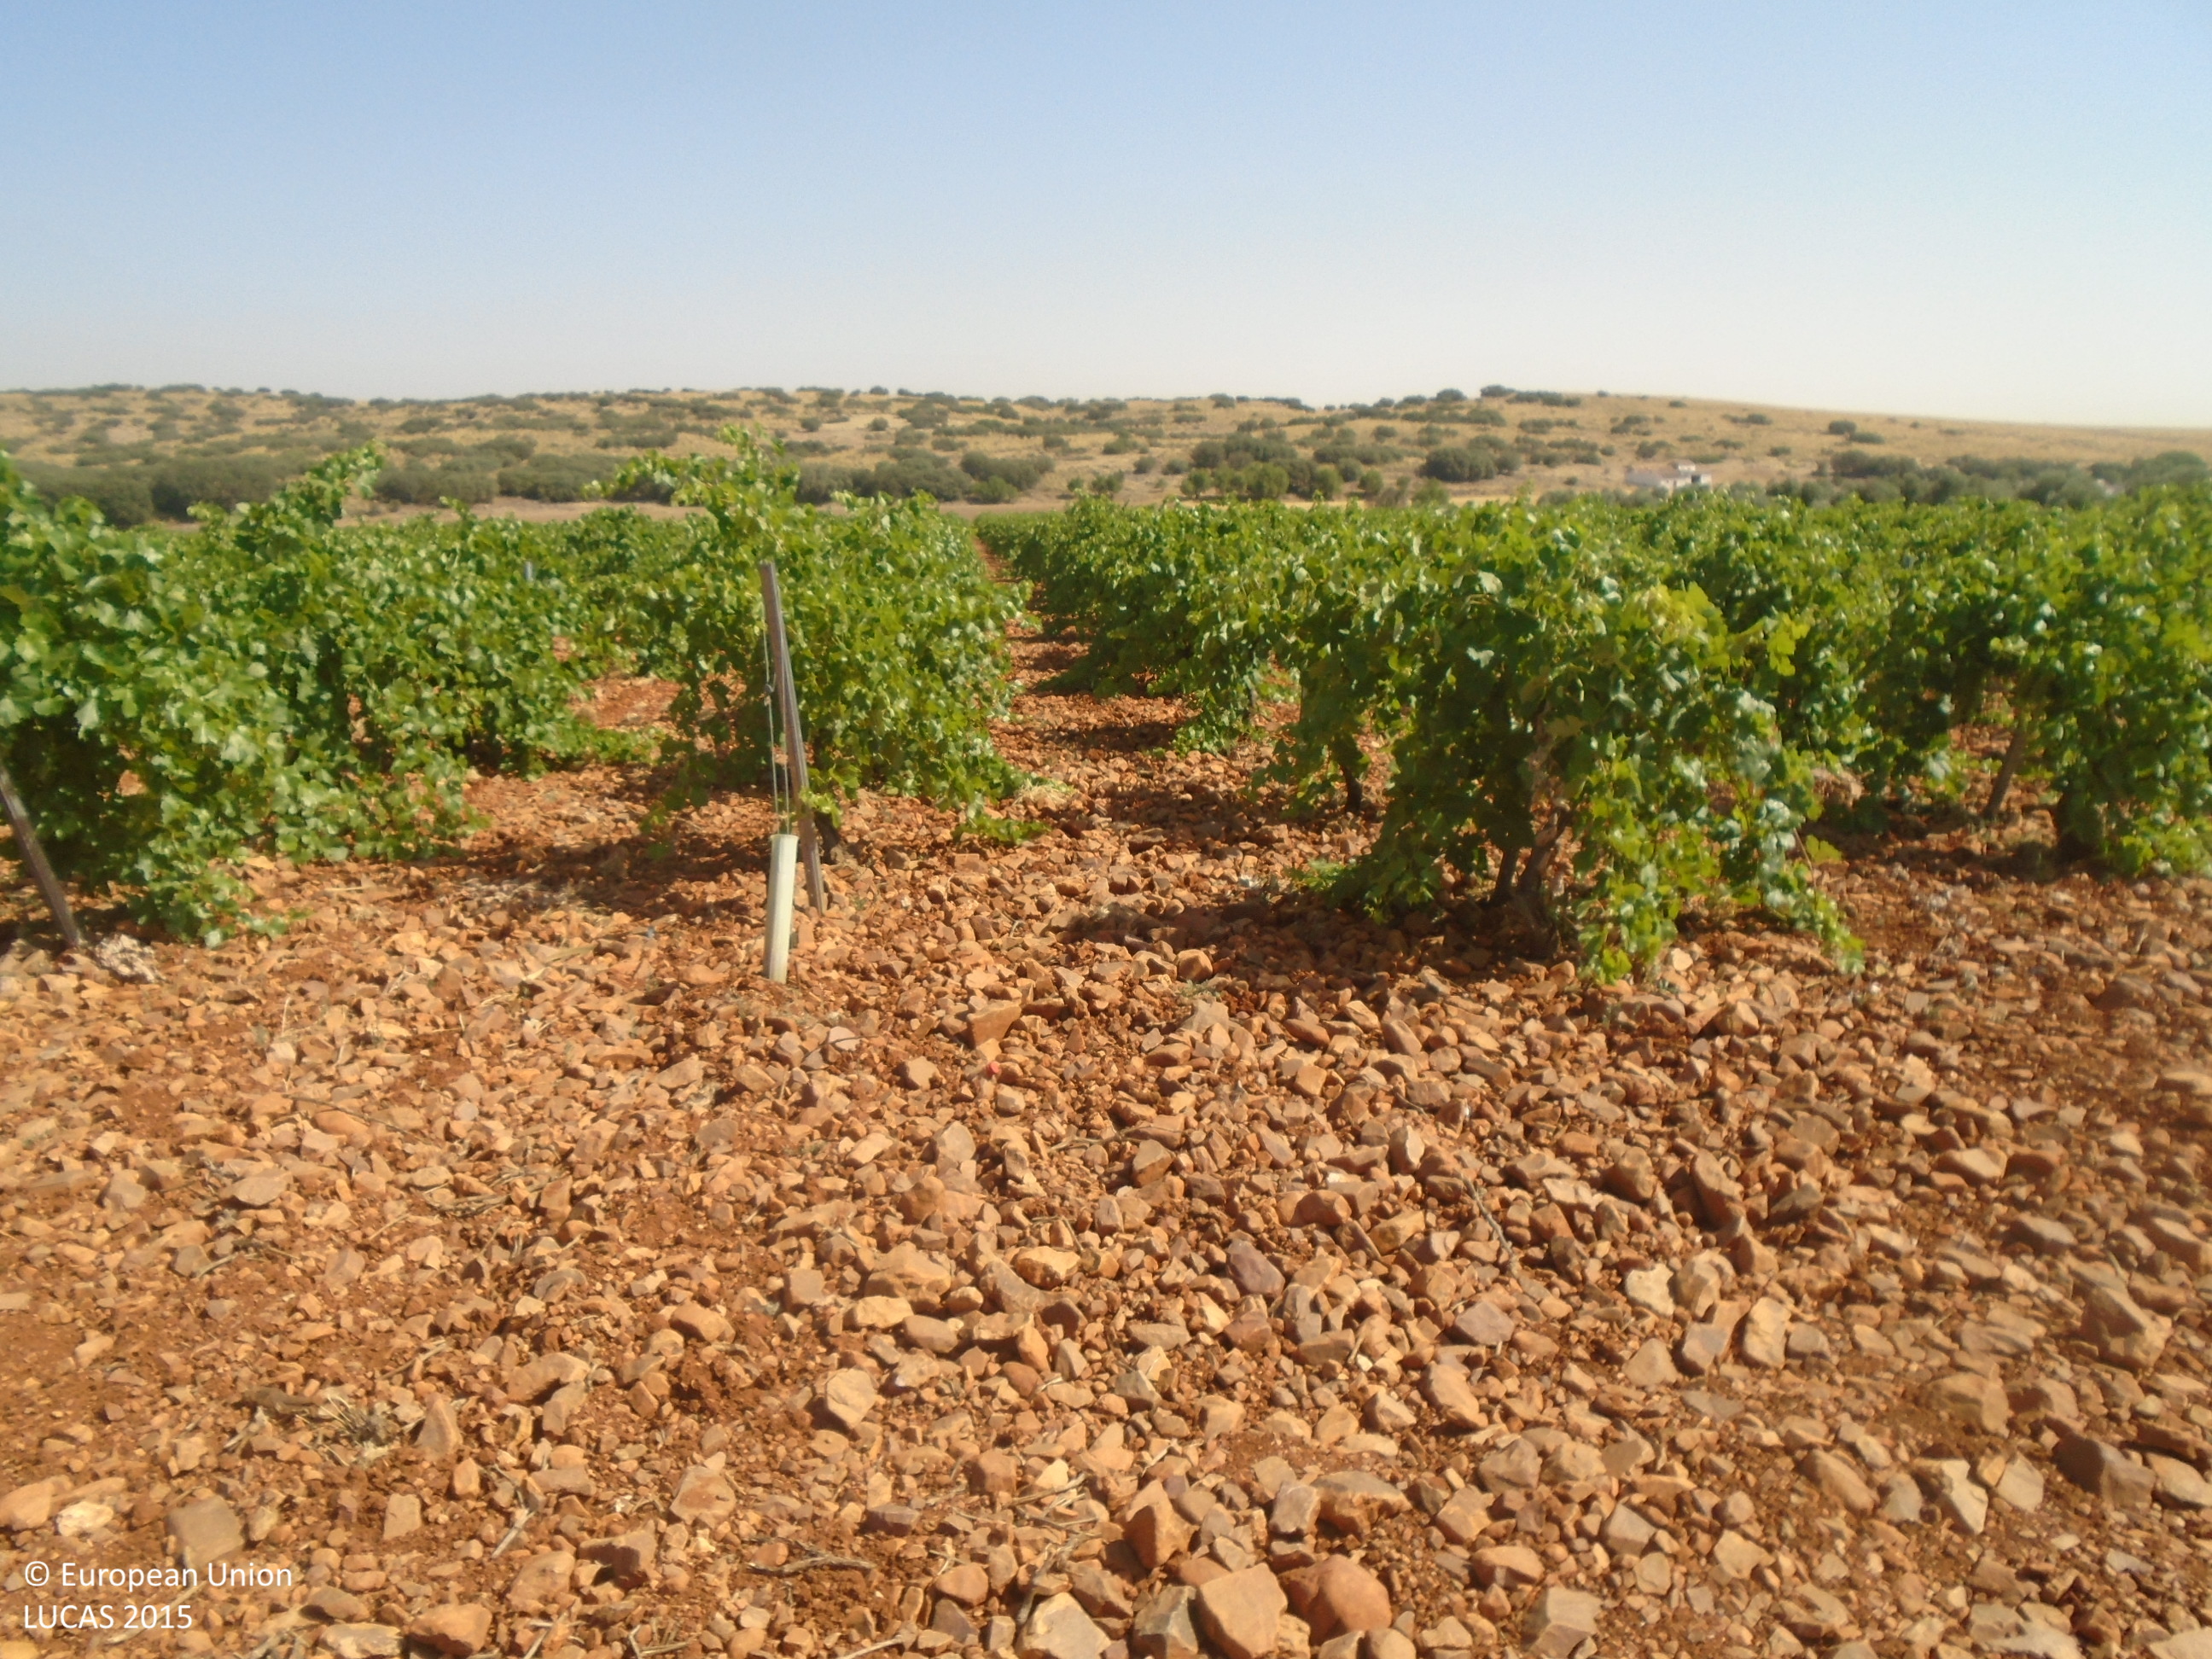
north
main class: Cropland
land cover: Vineyards
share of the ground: 25 - 50 %
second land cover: Other bare soil
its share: > 75 %
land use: Agriculture (excluding fallow land and kitchen gardens)
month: July
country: ES
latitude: 39.3975
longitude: -3.6673
